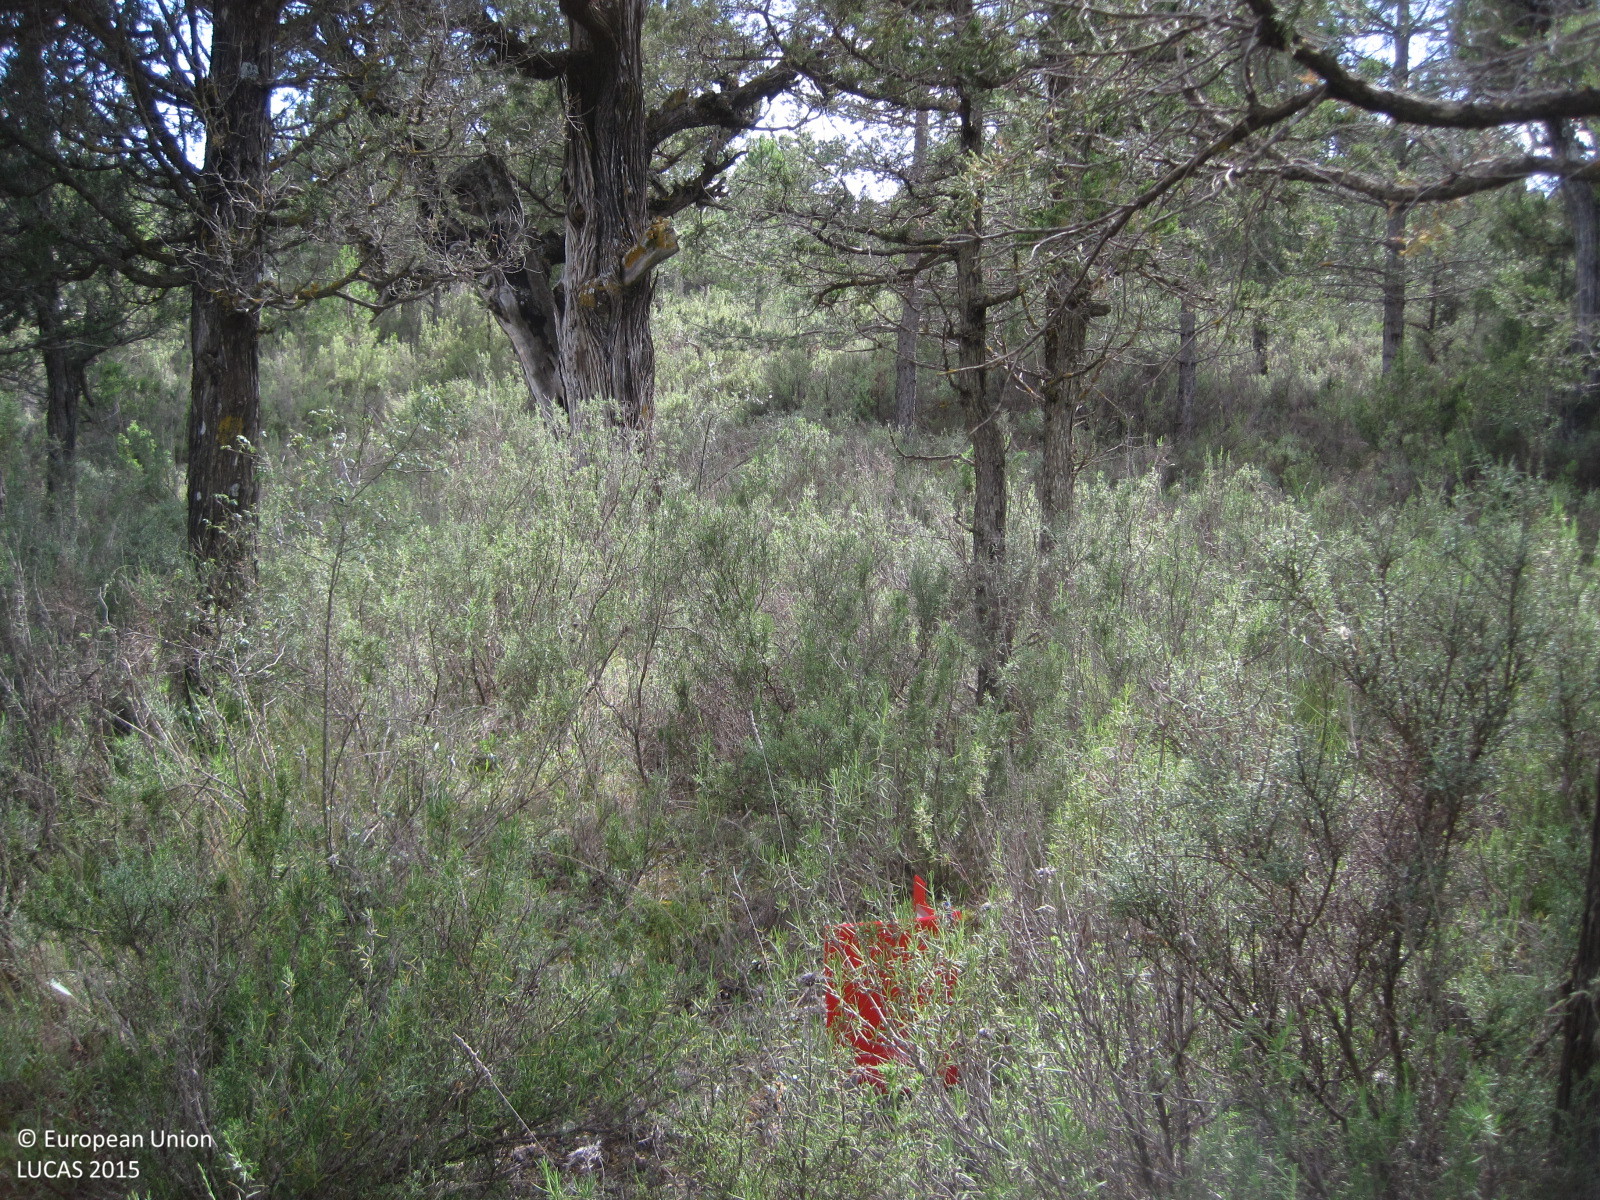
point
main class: Woodland
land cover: Other coniferous woodland
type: coniferous forest of the mediterranean region
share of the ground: 50 - 75 %
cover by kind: coniferous forest trees 55 %, shrubs 25 %, herbaceous plants 15 %, lichens and mosses 5 %
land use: Forestry
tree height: > 5 m
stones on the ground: 25 - 50 %
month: June
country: ES
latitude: 39.9573
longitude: -0.9977
